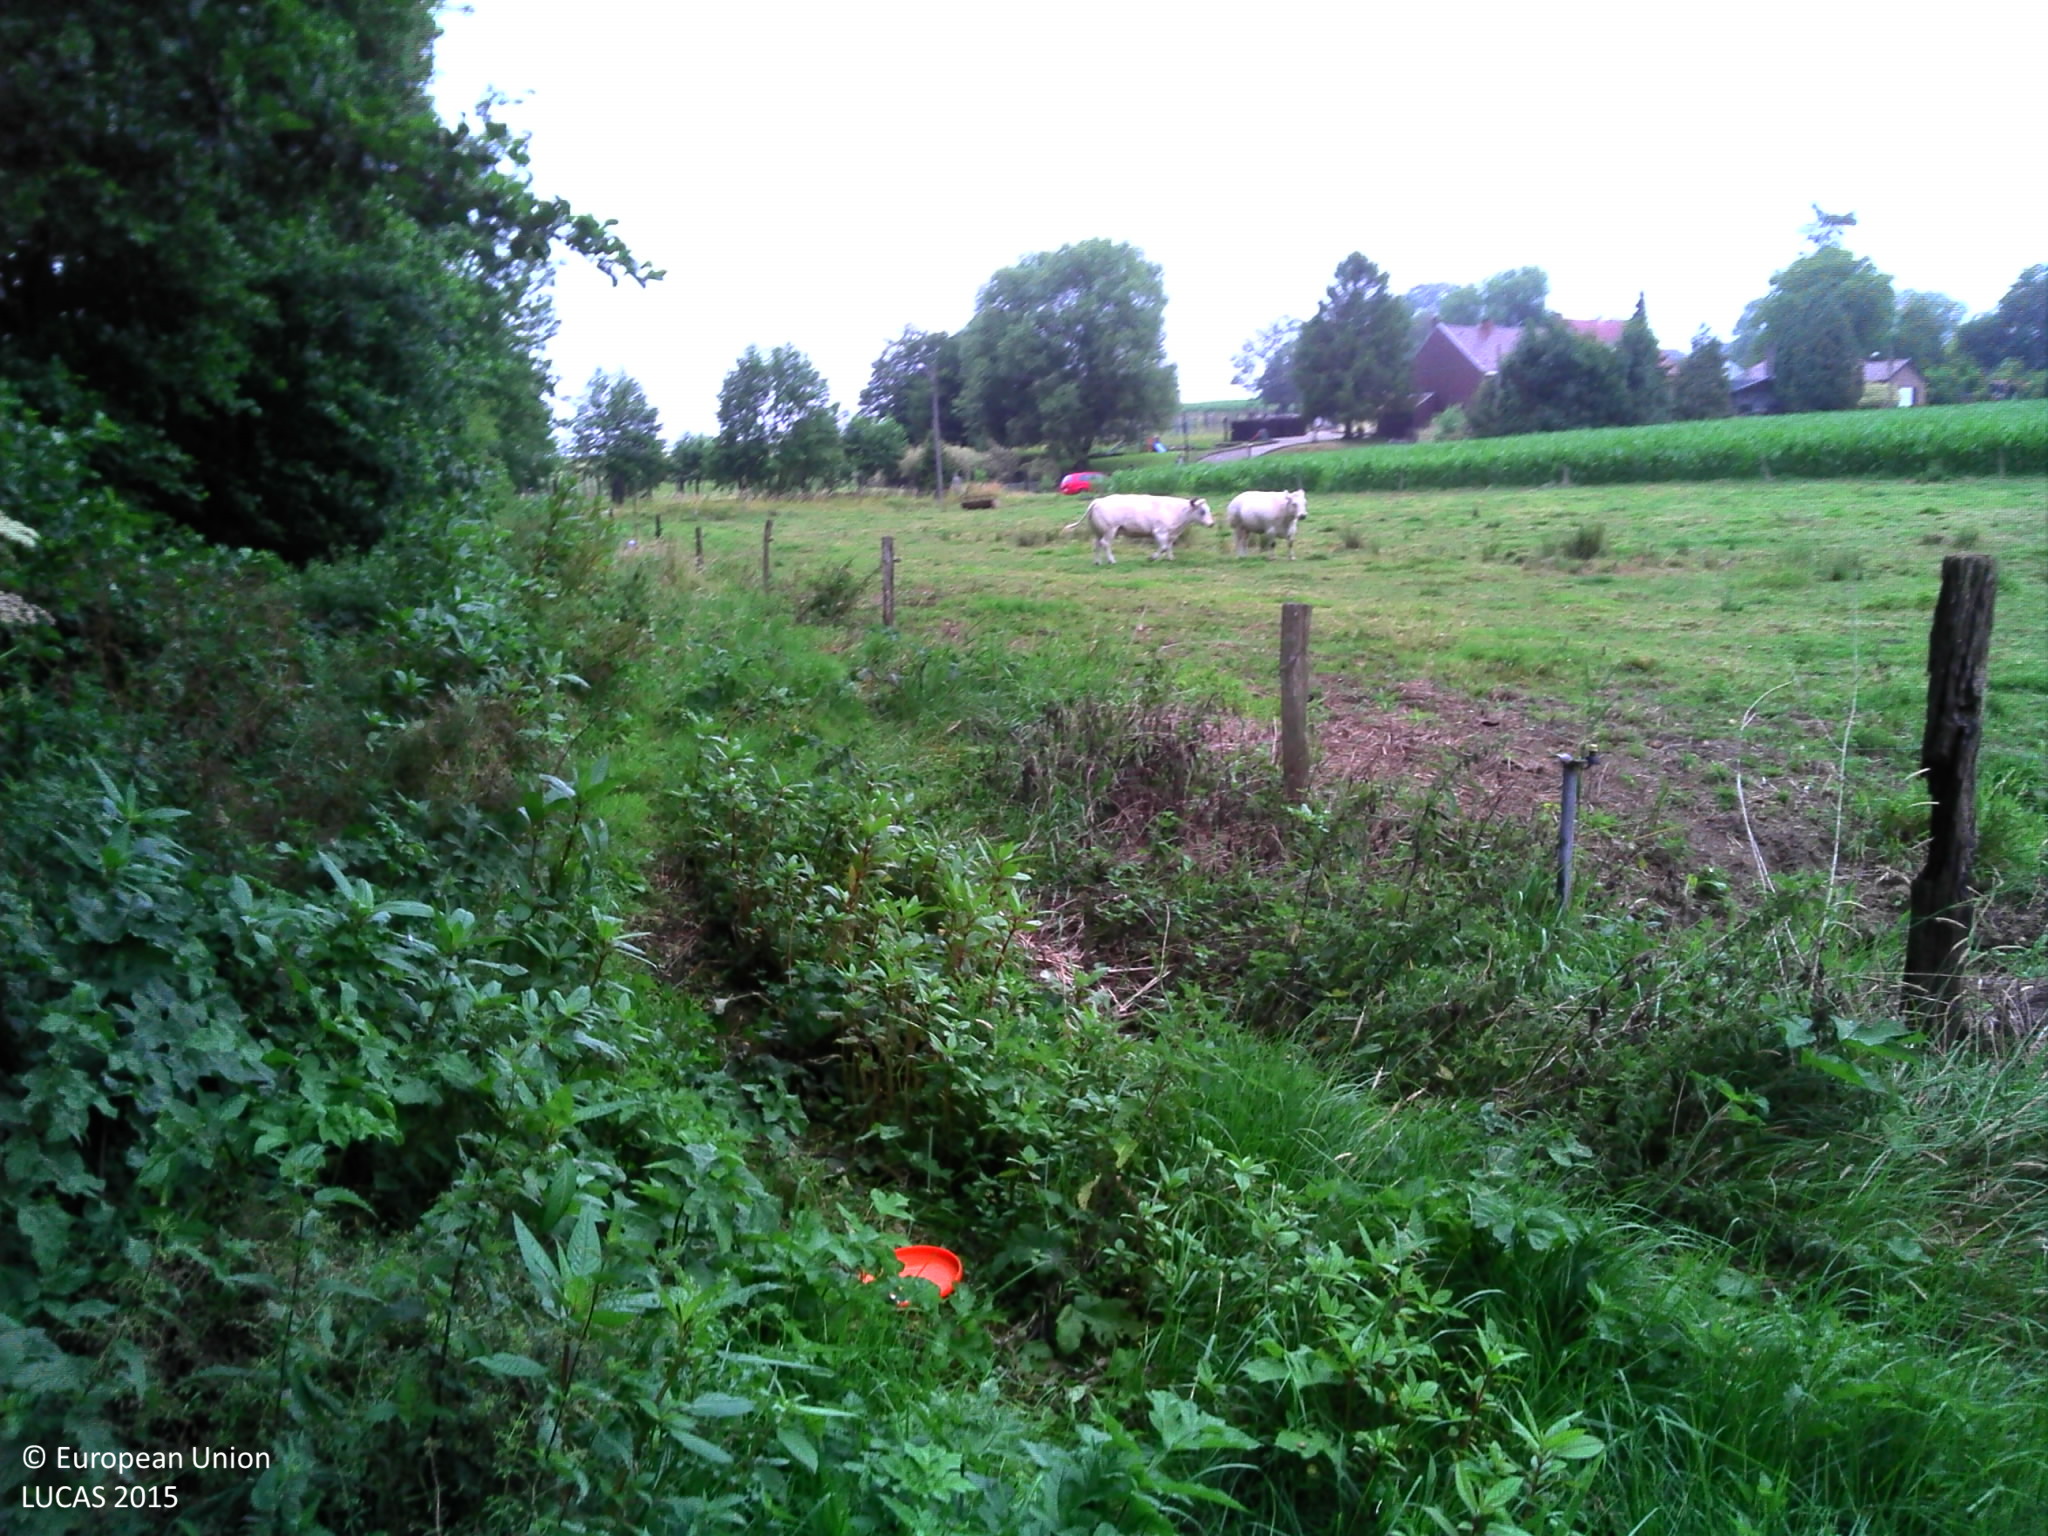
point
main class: Grassland
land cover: Grassland without tree/shrub cover
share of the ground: > 75 %
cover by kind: herbaceous plants 95 %, shrubs 5 %
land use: Agriculture (excluding fallow land and kitchen gardens)
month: July
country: BE
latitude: 50.6221
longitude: 4.0152
